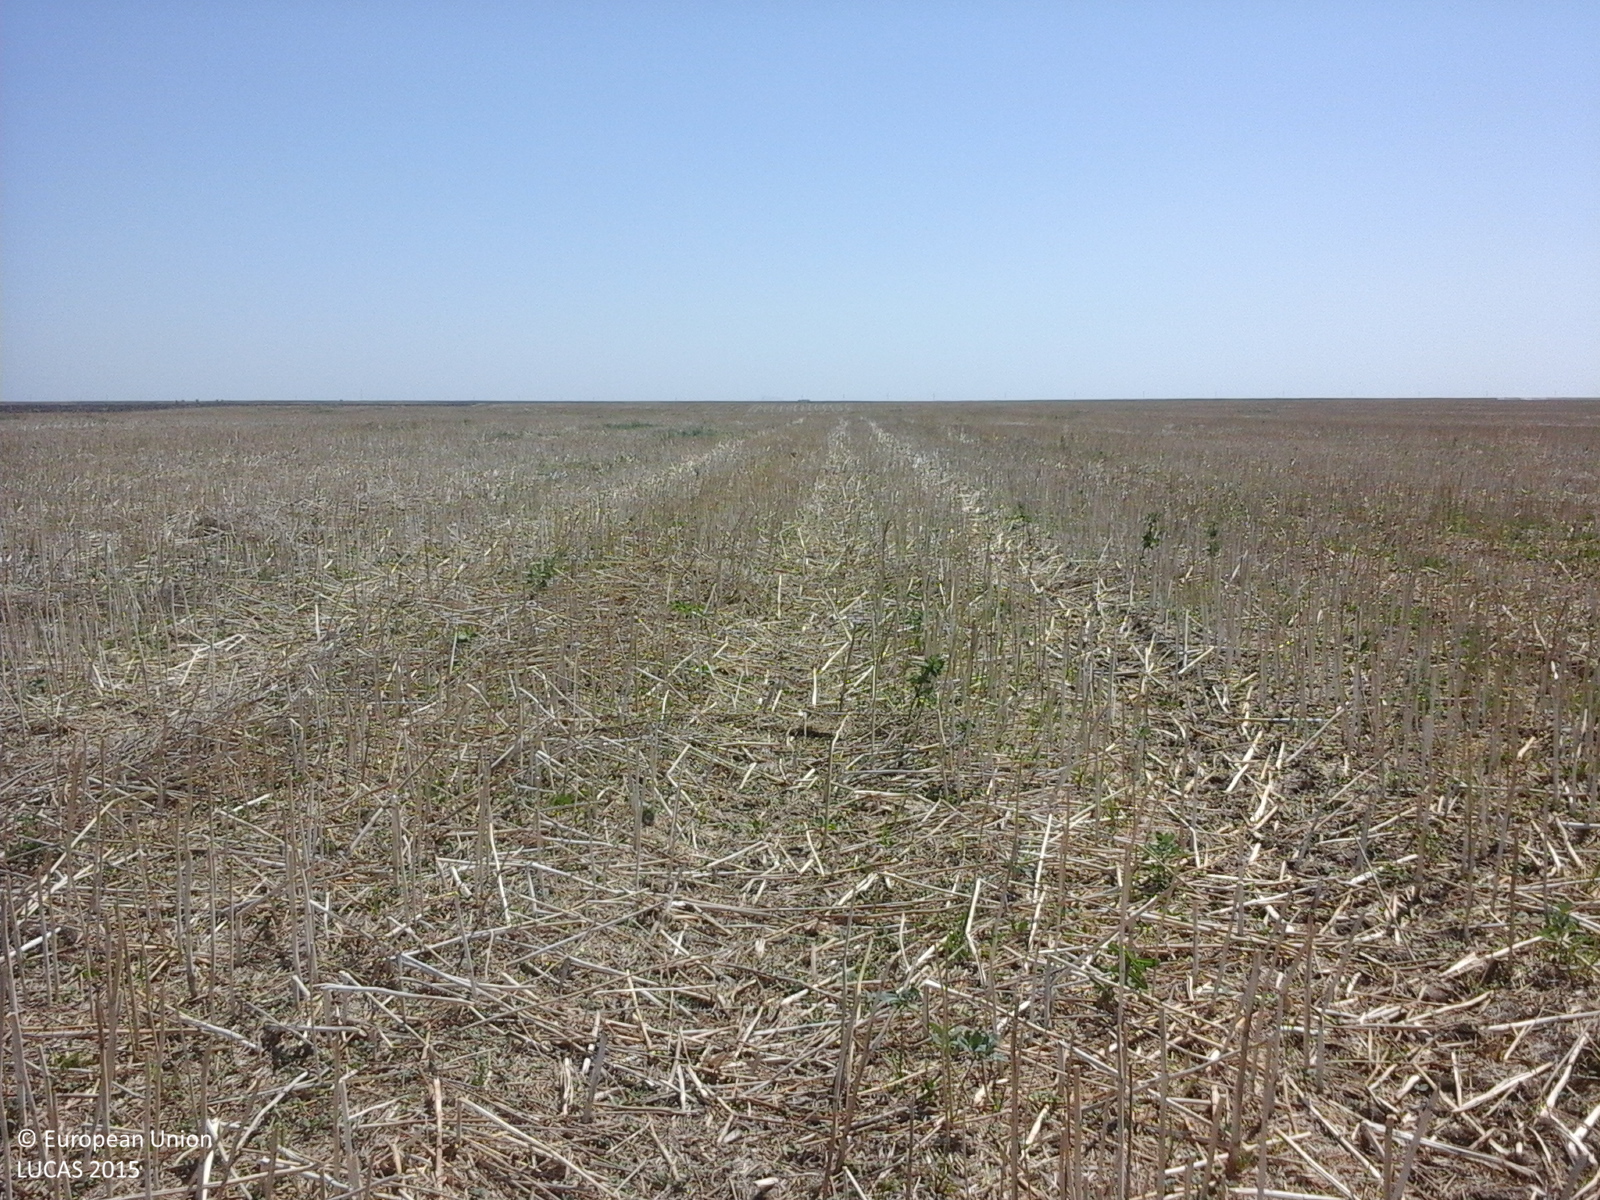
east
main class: Cropland
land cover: Rape and turnip rape
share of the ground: 10 - 25 %
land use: Agriculture (excluding fallow land and kitchen gardens)
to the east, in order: Rape and turnip rape
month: July
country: RO
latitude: 44.3088
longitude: 26.7041
